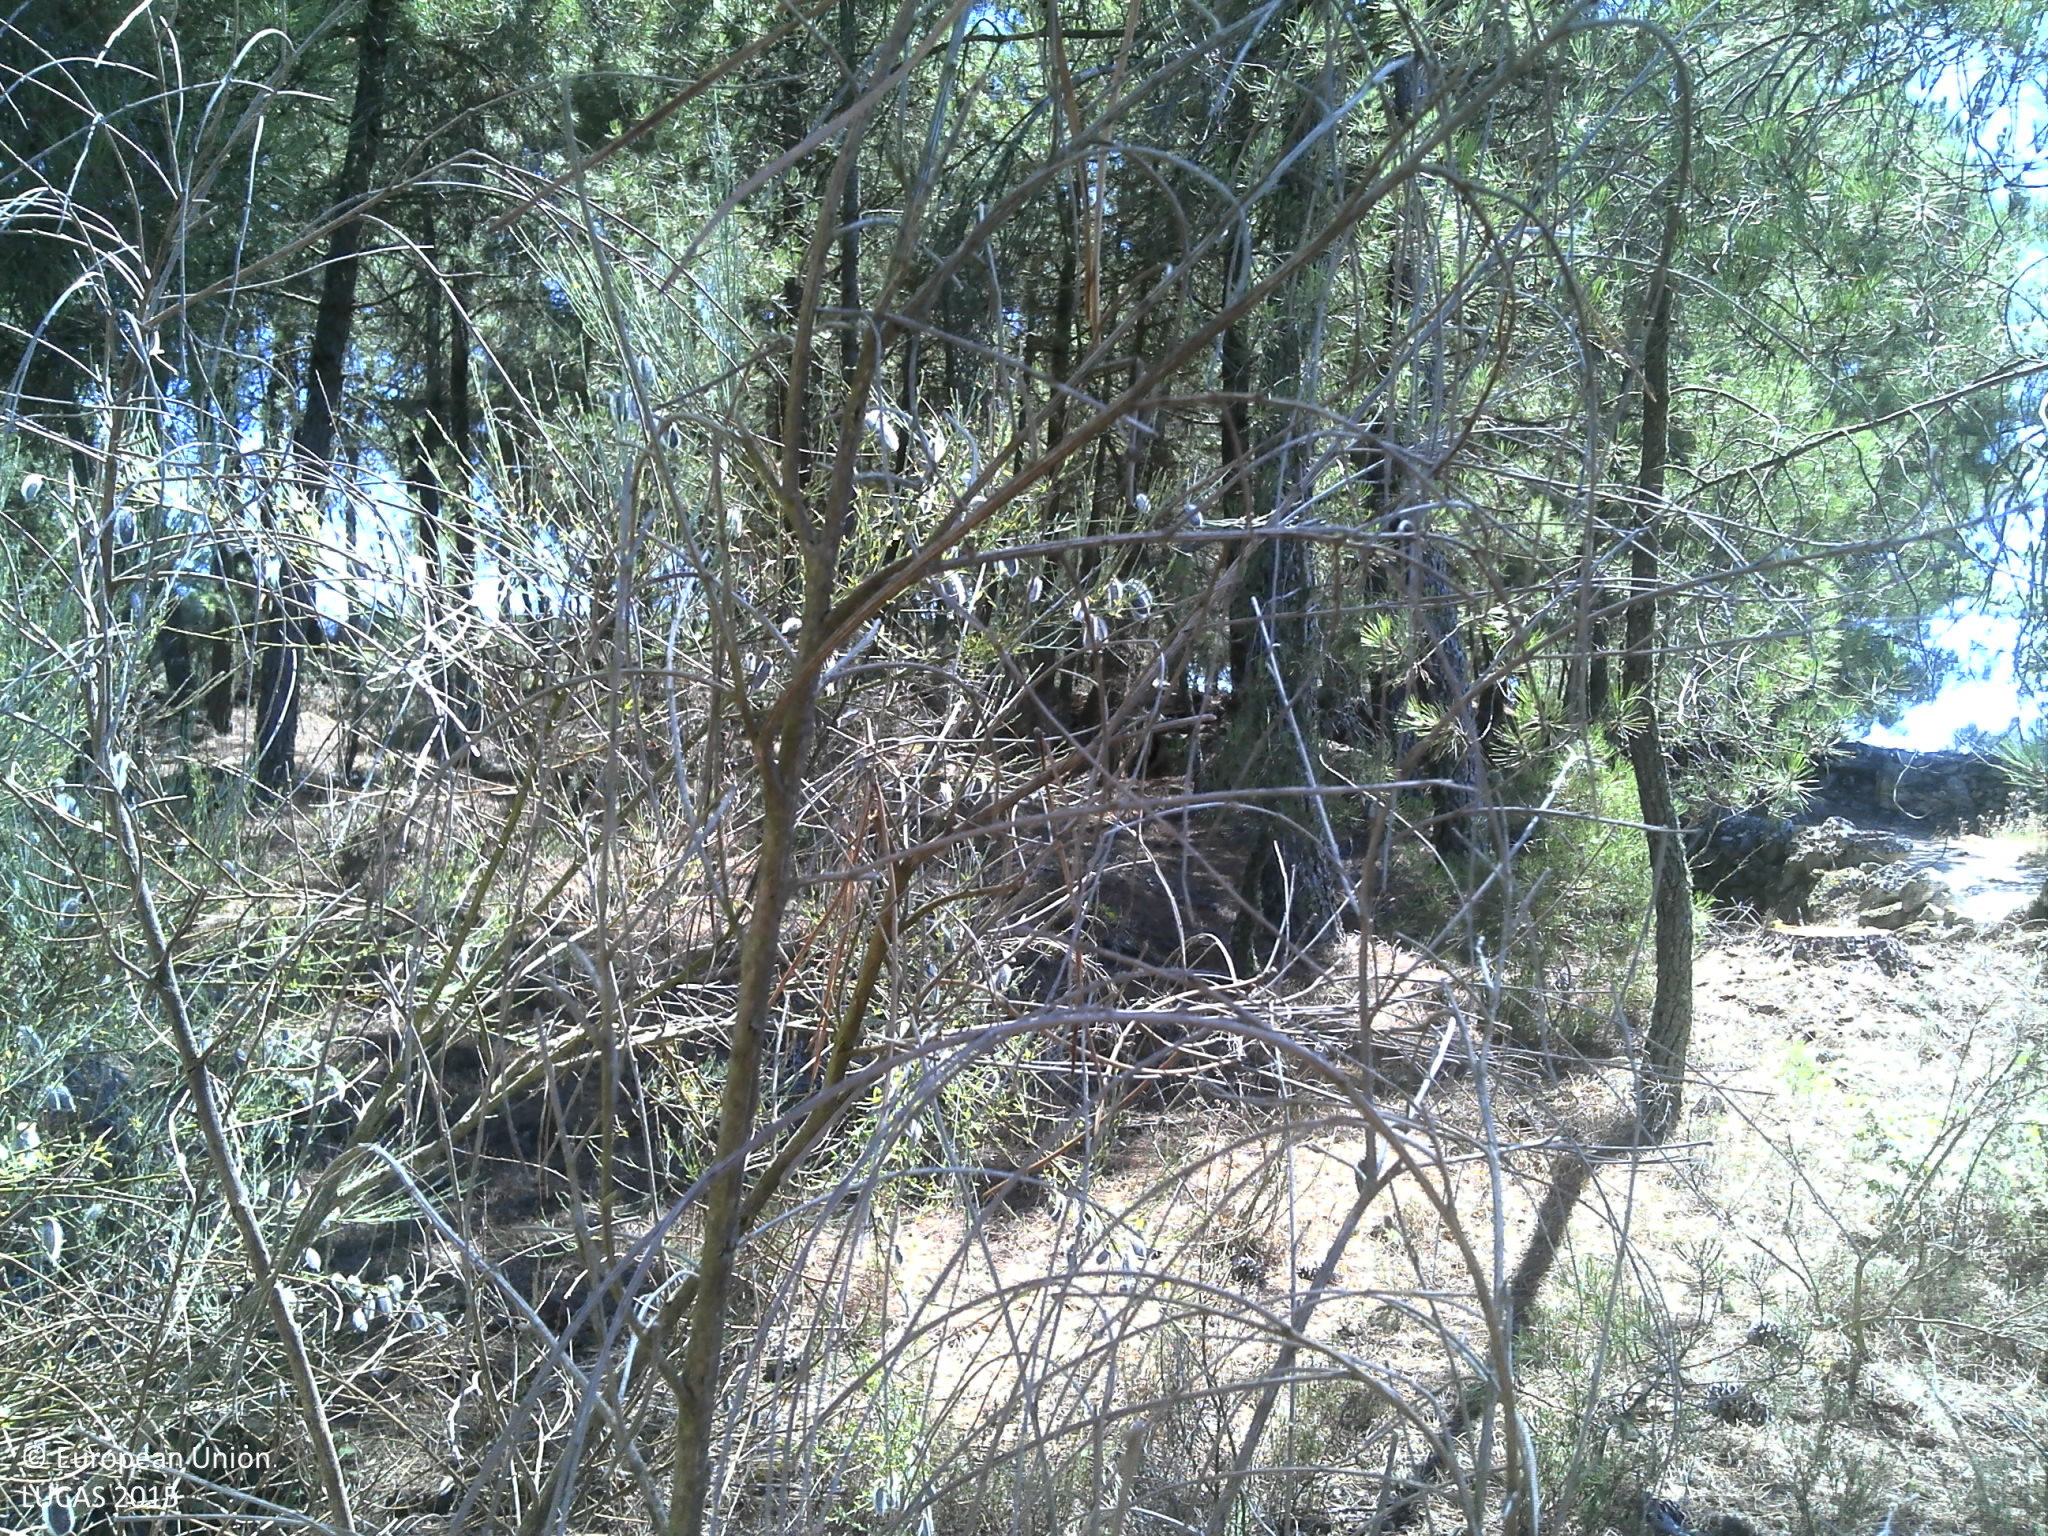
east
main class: Woodland
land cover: Pine dominated coniferous woodland
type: coniferous forest of the mediterranean region
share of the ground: < 10 %
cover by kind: unconsolidated bare surface 50 %, shrubs 30 %, coniferous forest trees 20 %
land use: Forestry
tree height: > 5 m
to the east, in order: Pine dominated coniferous woodland; Dry stone walls; Tracks; Dry stone walls; Nuts trees; Grassland without tree/shrub cover; Grassland with sparse tree/shrub cover; Ponds and wetlands; Dry stone walls; Grassland without tree/shrub cover; Shrubland with sparse tree cover; Pine dominated coniferous woodland; Electric lines; Pine dominated coniferous woodland; Fences; Tracks; Pine dominated coniferous woodland
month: July
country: PT
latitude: 41.2460
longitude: -7.2894
